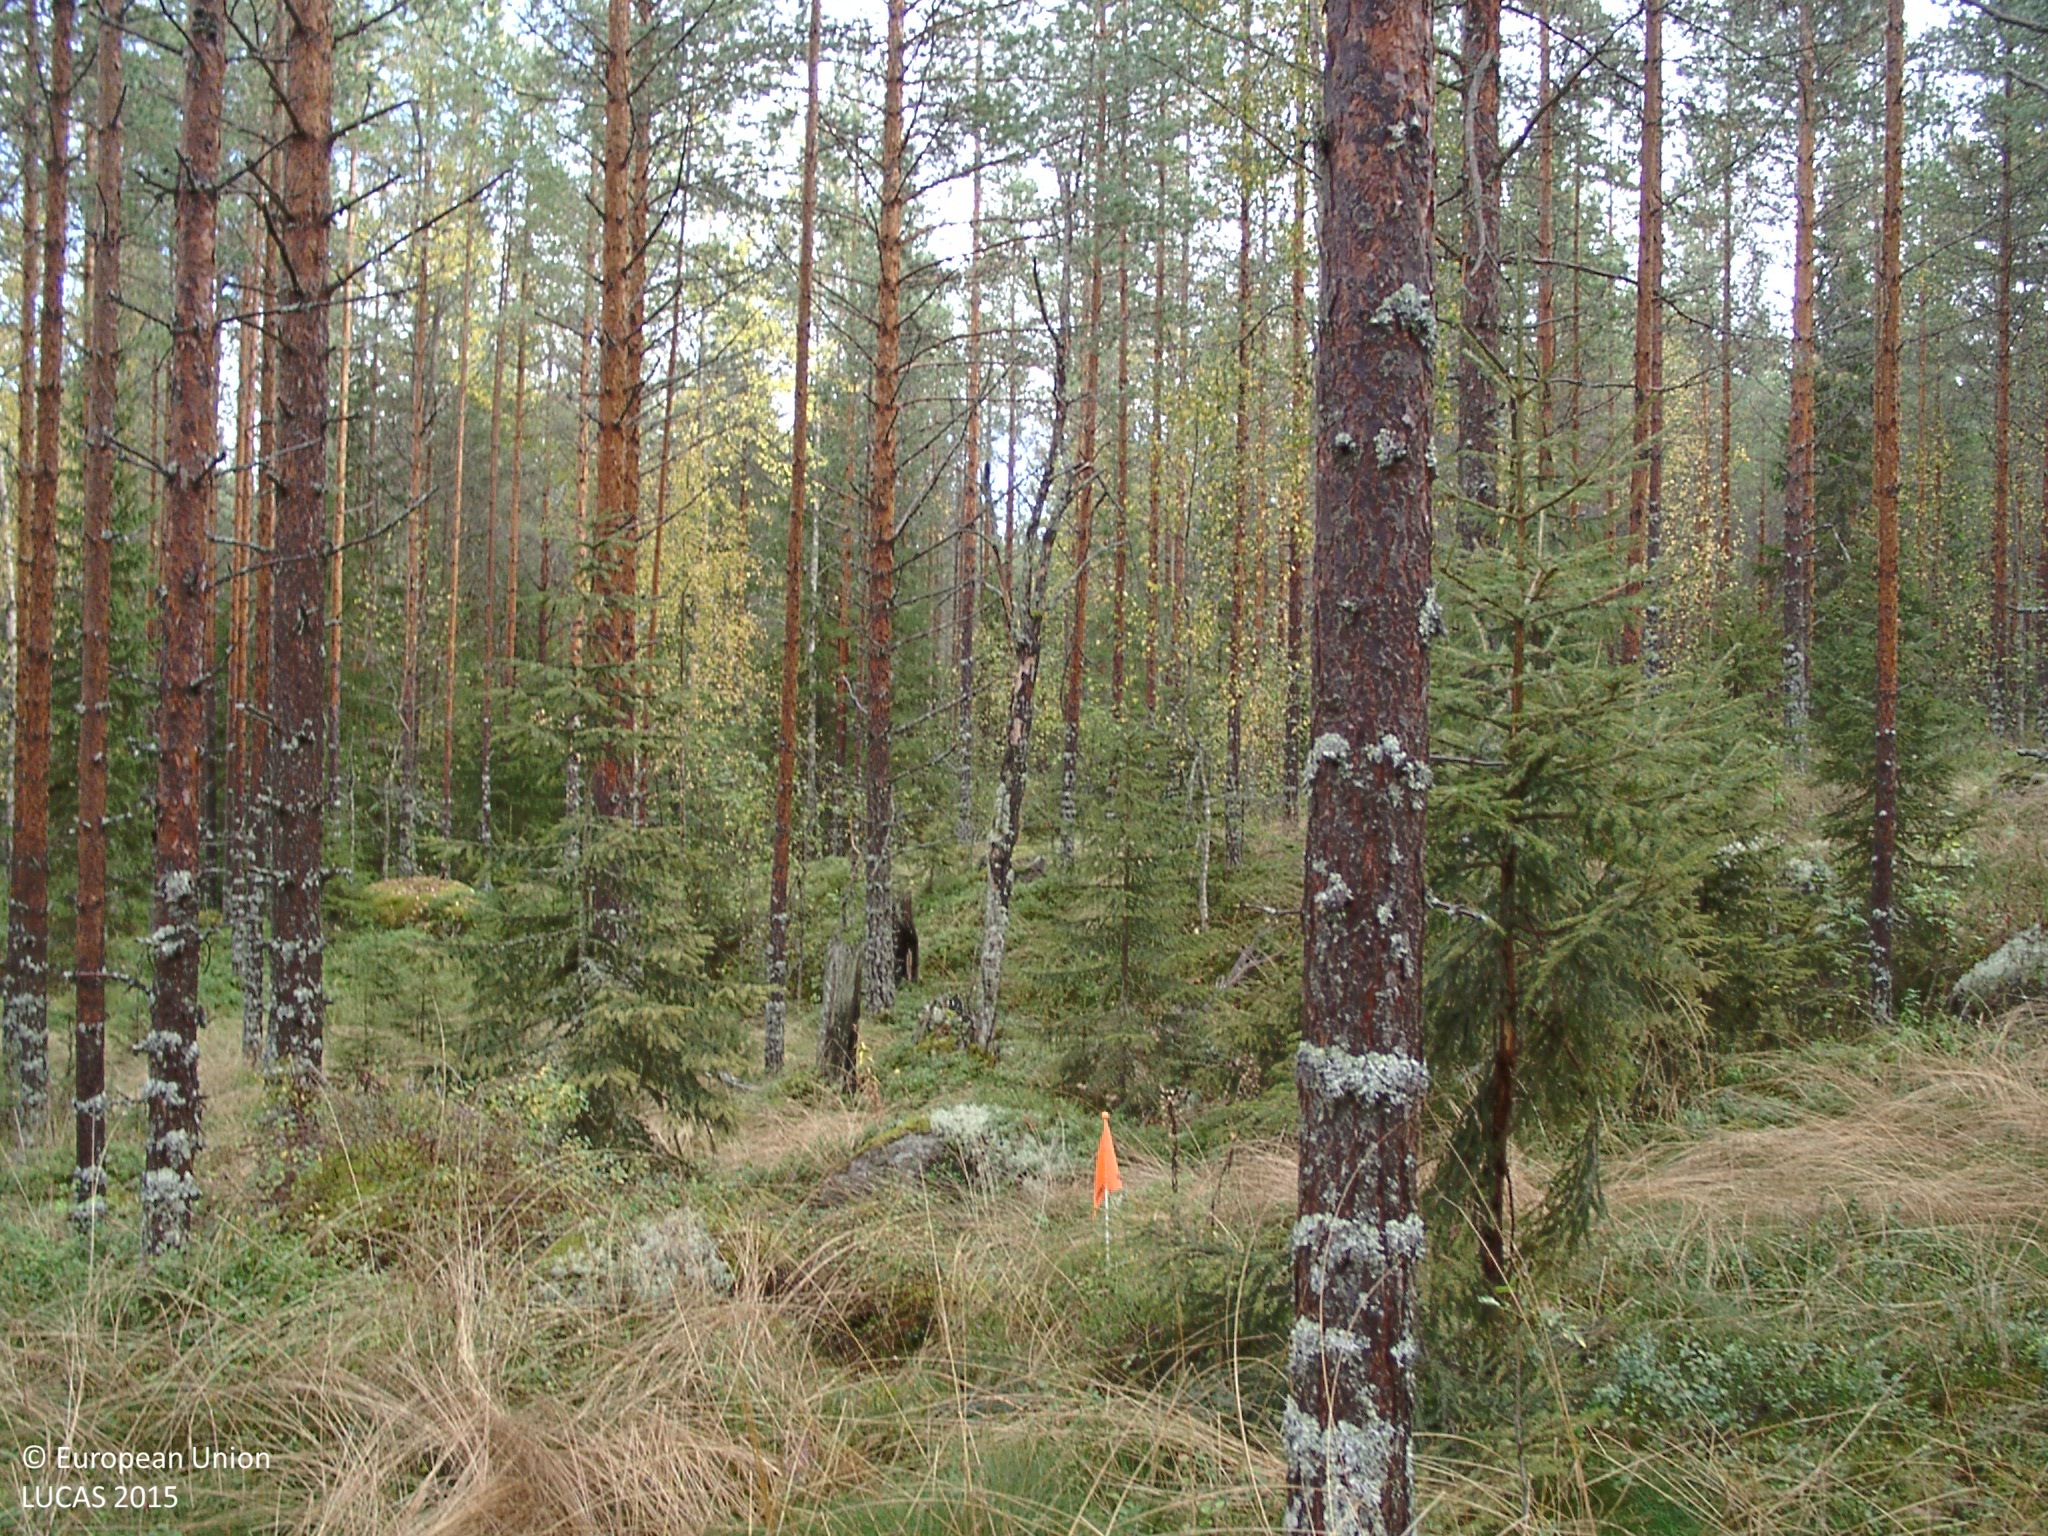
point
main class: Woodland
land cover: Pine dominated coniferous woodland
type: boreal forest
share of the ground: 50 - 75 %
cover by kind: coniferous forest trees 60 %, shrubs 15 %, herbaceous plants 15 %, lichens and mosses 10 %
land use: Forestry
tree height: > 5 m
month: September
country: FI
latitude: 62.7436
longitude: 25.6735
